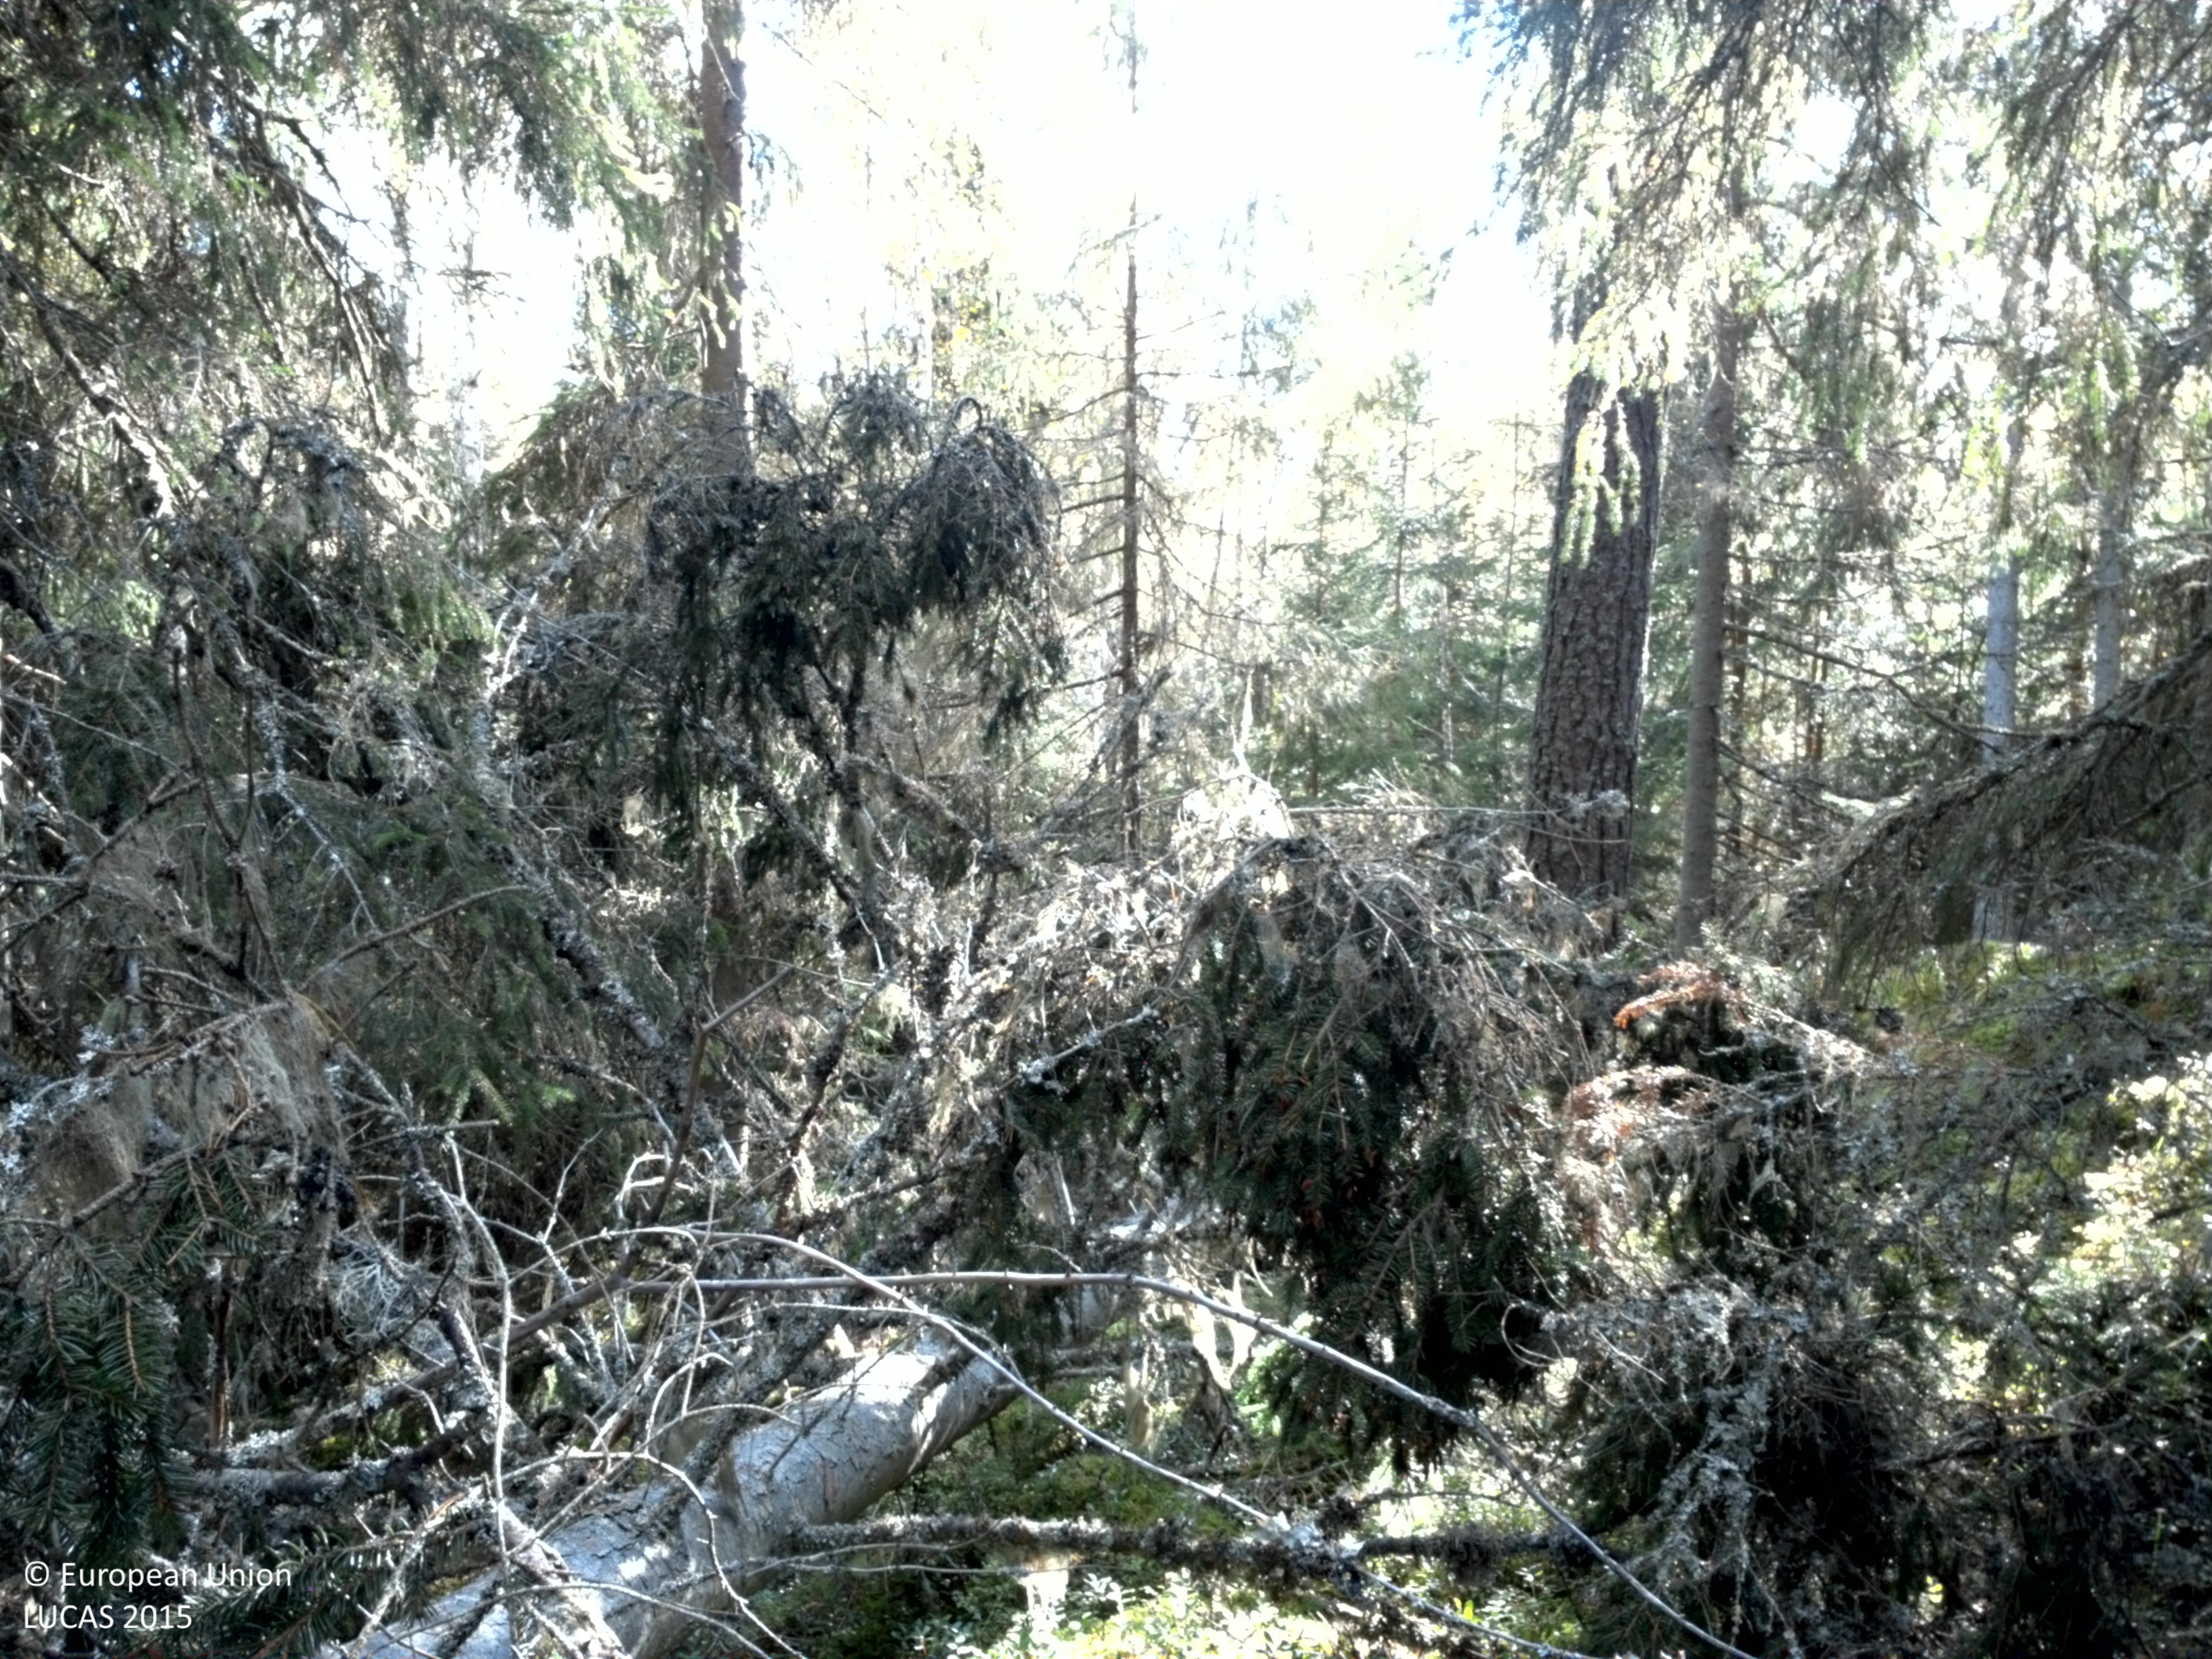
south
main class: Woodland
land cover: Spruce dominated coniferous woodland
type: boreal forest
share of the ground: > 75 %
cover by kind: coniferous forest trees 75 %, lichens and mosses 25 %
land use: Forestry
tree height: > 5 m
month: September
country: SE
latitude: 60.1543
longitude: 16.5652
